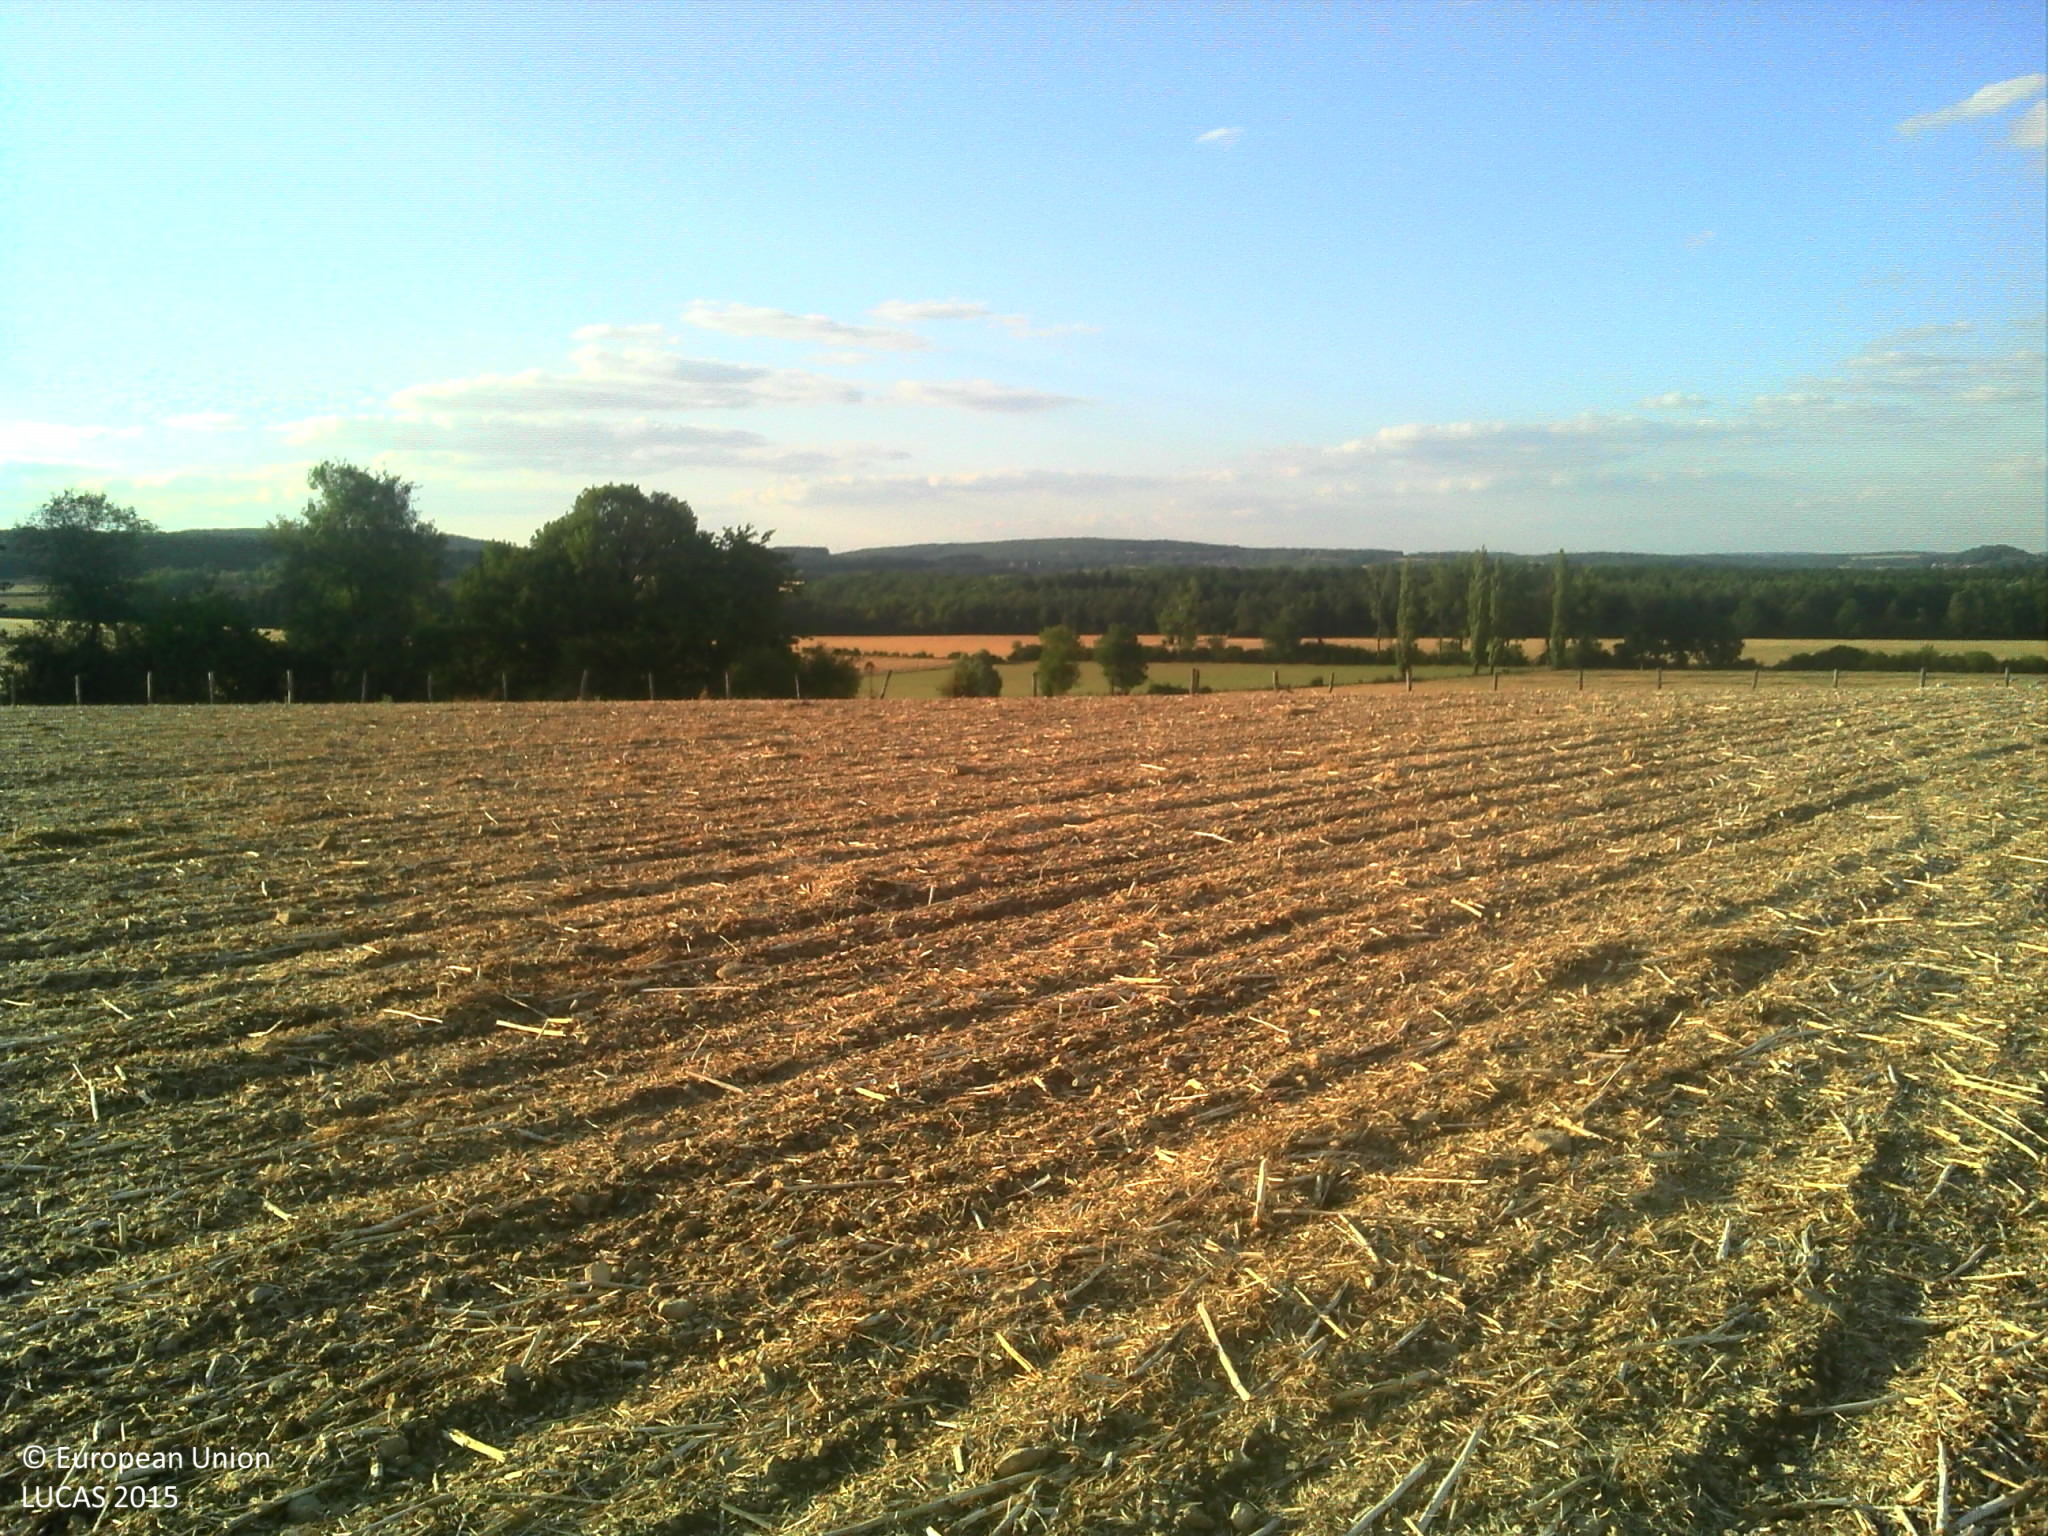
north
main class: Cropland
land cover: Rape and turnip rape
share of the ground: < 10 %
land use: Agriculture (excluding fallow land and kitchen gardens)
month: July
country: FR
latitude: 47.6176
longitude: 5.2771
